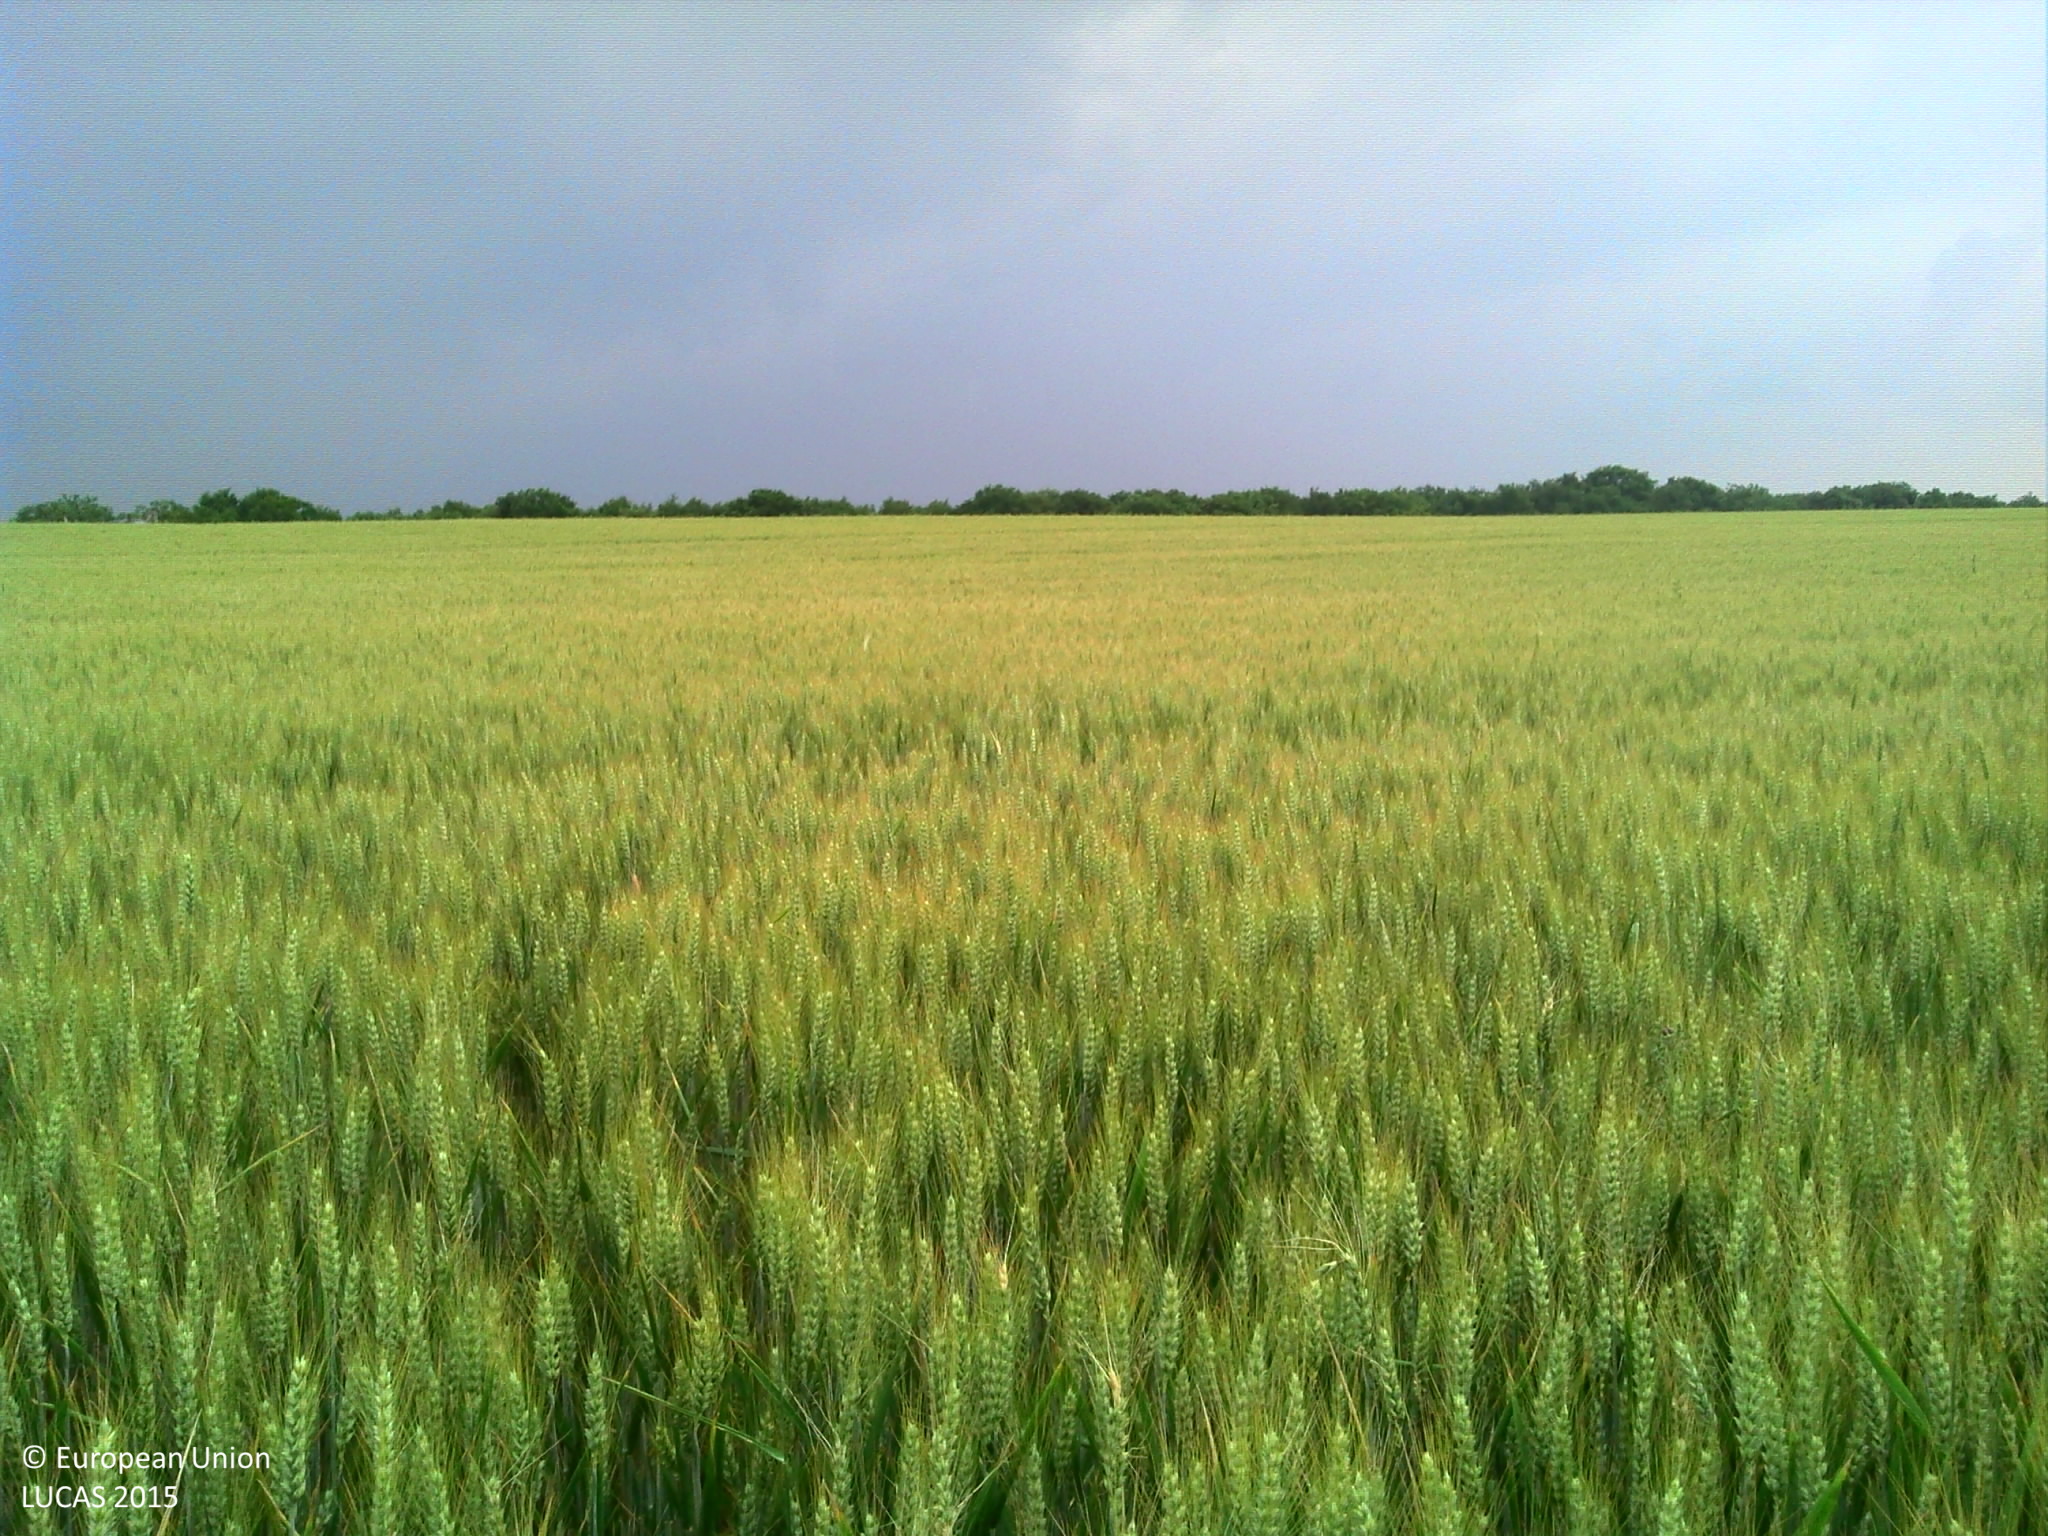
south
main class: Cropland
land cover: Common wheat
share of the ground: > 75 %
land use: Agriculture (excluding fallow land and kitchen gardens)
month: June
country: FR
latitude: 48.2124
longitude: 4.8711
